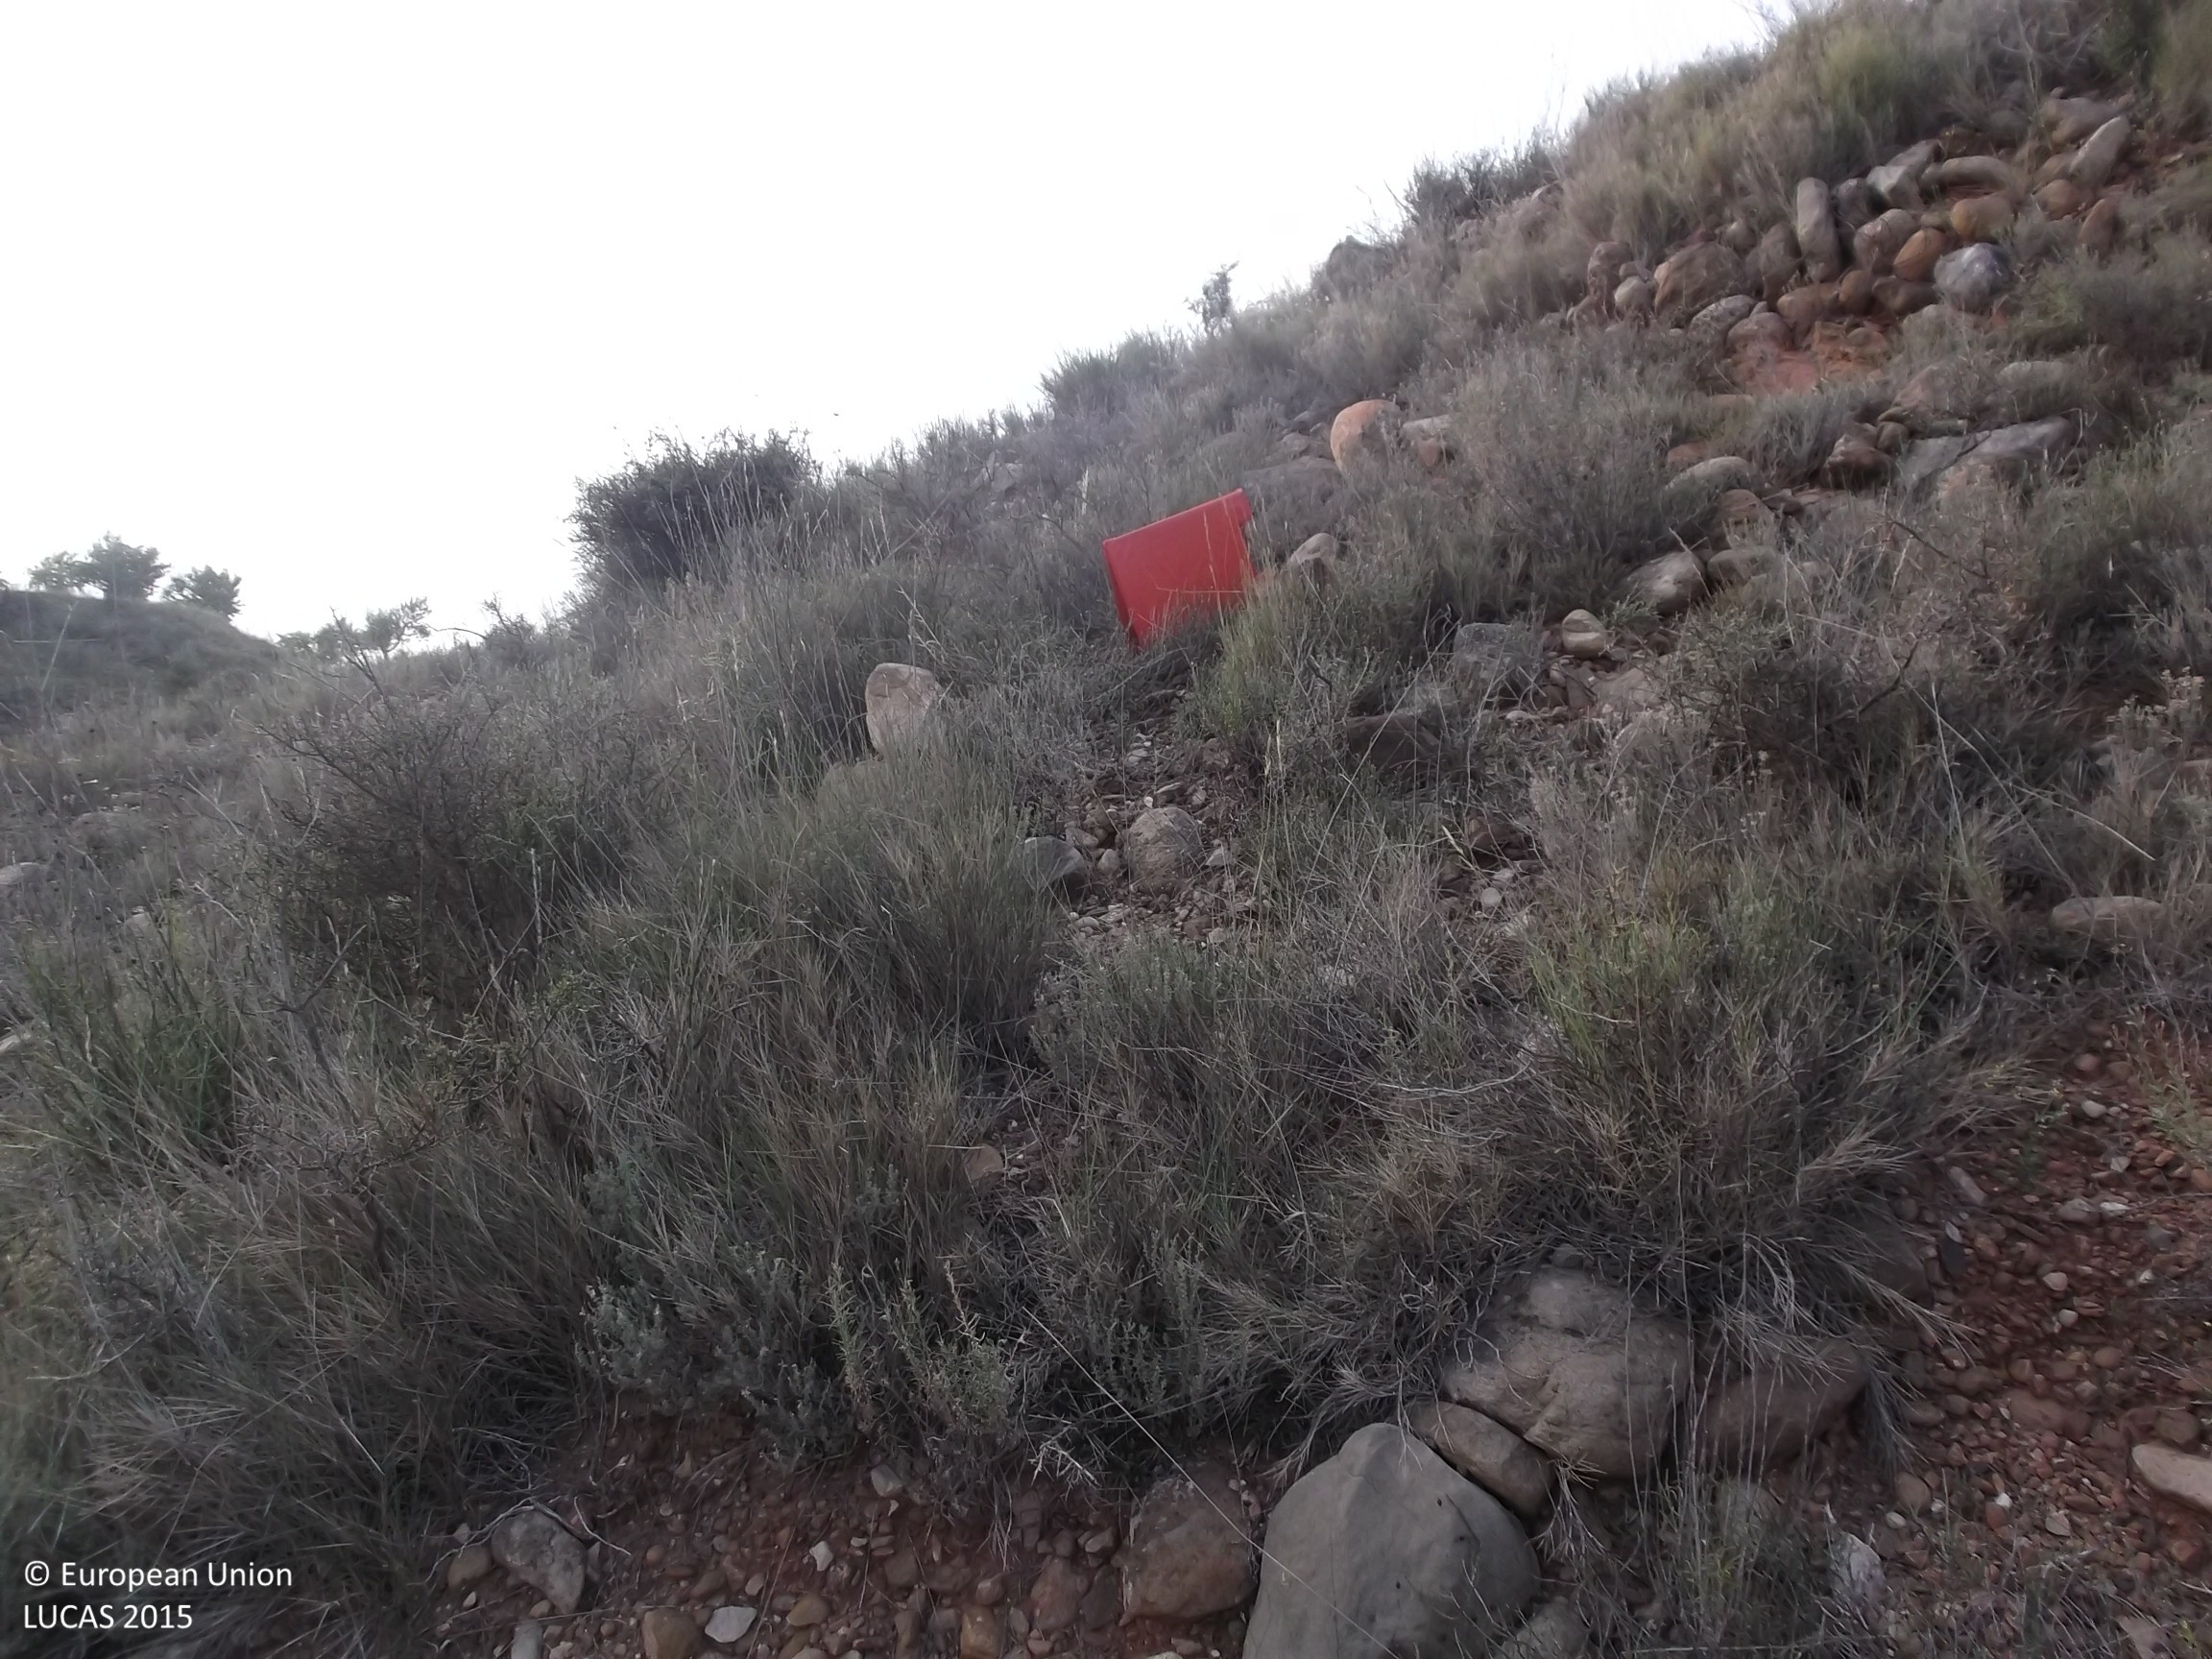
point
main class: Shrubland
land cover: Shrubland without tree cover
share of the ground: 50 - 75 %
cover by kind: shrubs 50 %, herbaceous plants 30 %, unconsolidated bare surface 20 %
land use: Semi-natural and natural areas not in use
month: July
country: ES
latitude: 42.1830
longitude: -2.0849
